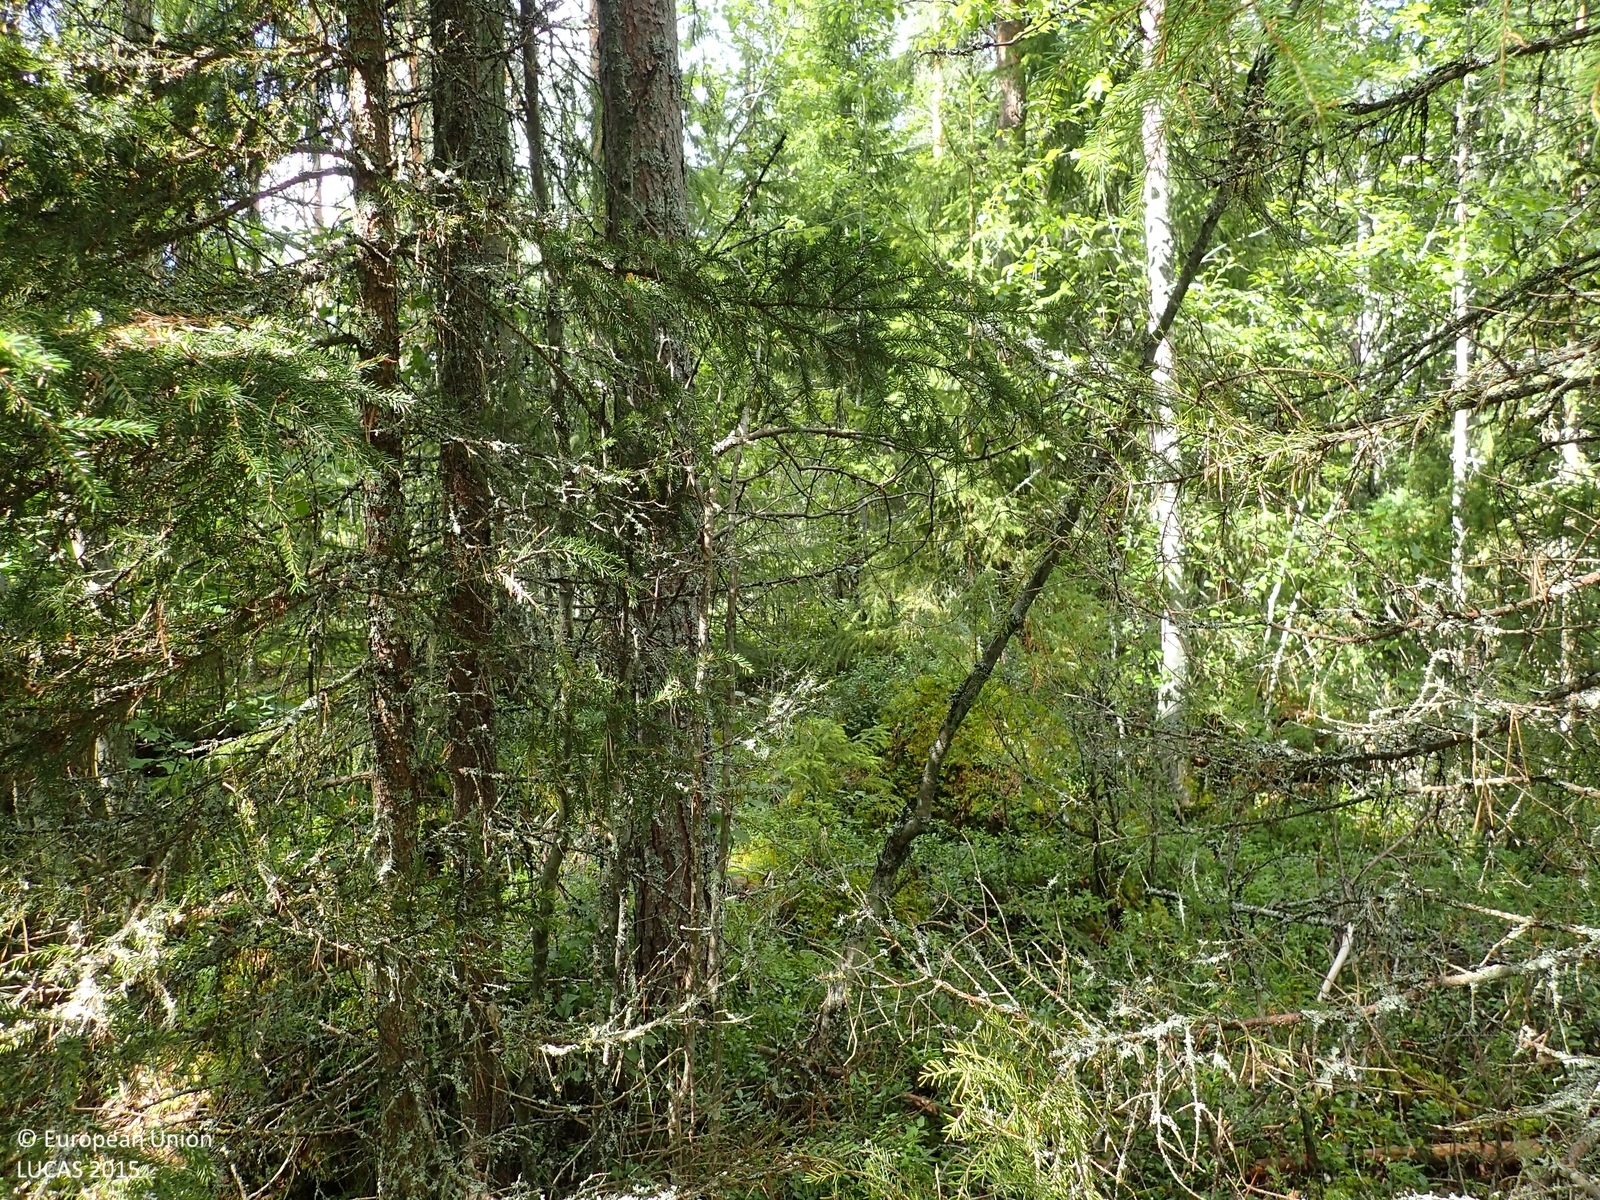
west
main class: Woodland
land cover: Pine dominated mixed woodland
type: boreal forest
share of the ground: > 75 %
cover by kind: coniferous forest trees 60 %, broadleaved forest trees 20 %, shrubs 15 %, lichens and mosses 5 %
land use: Forestry
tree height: > 5 m
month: August
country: FI
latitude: 62.6926
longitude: 21.8274
